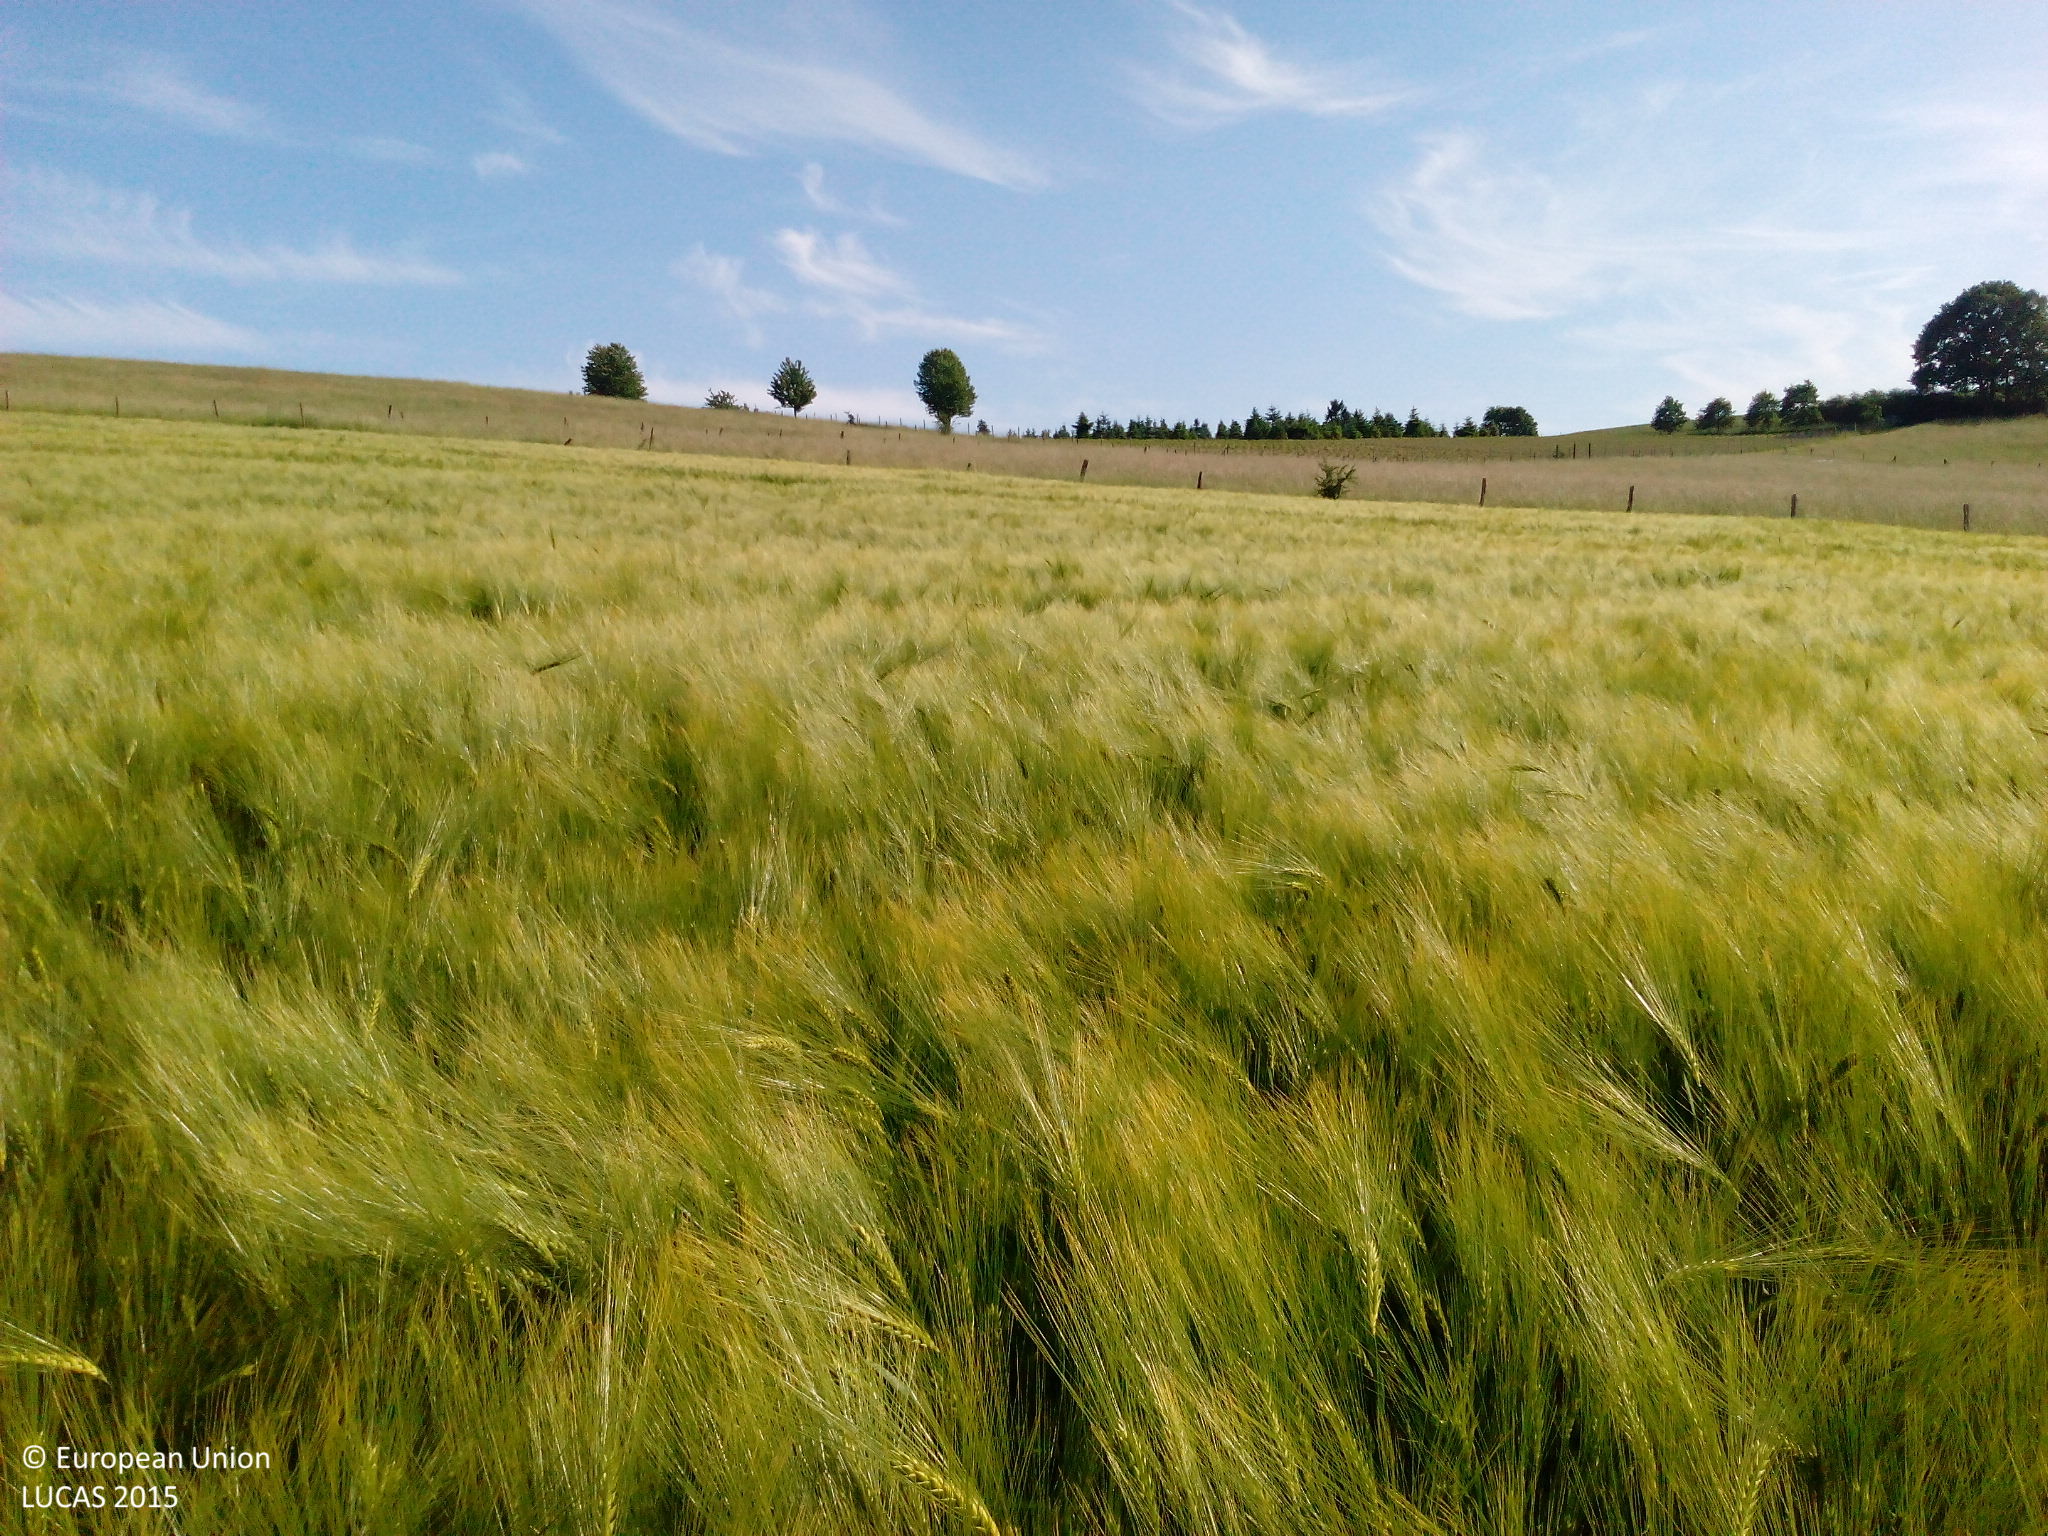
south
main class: Cropland
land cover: Barley
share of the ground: > 75 %
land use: Agriculture (excluding fallow land and kitchen gardens)
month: June
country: DE
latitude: 50.1686
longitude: 8.1104
